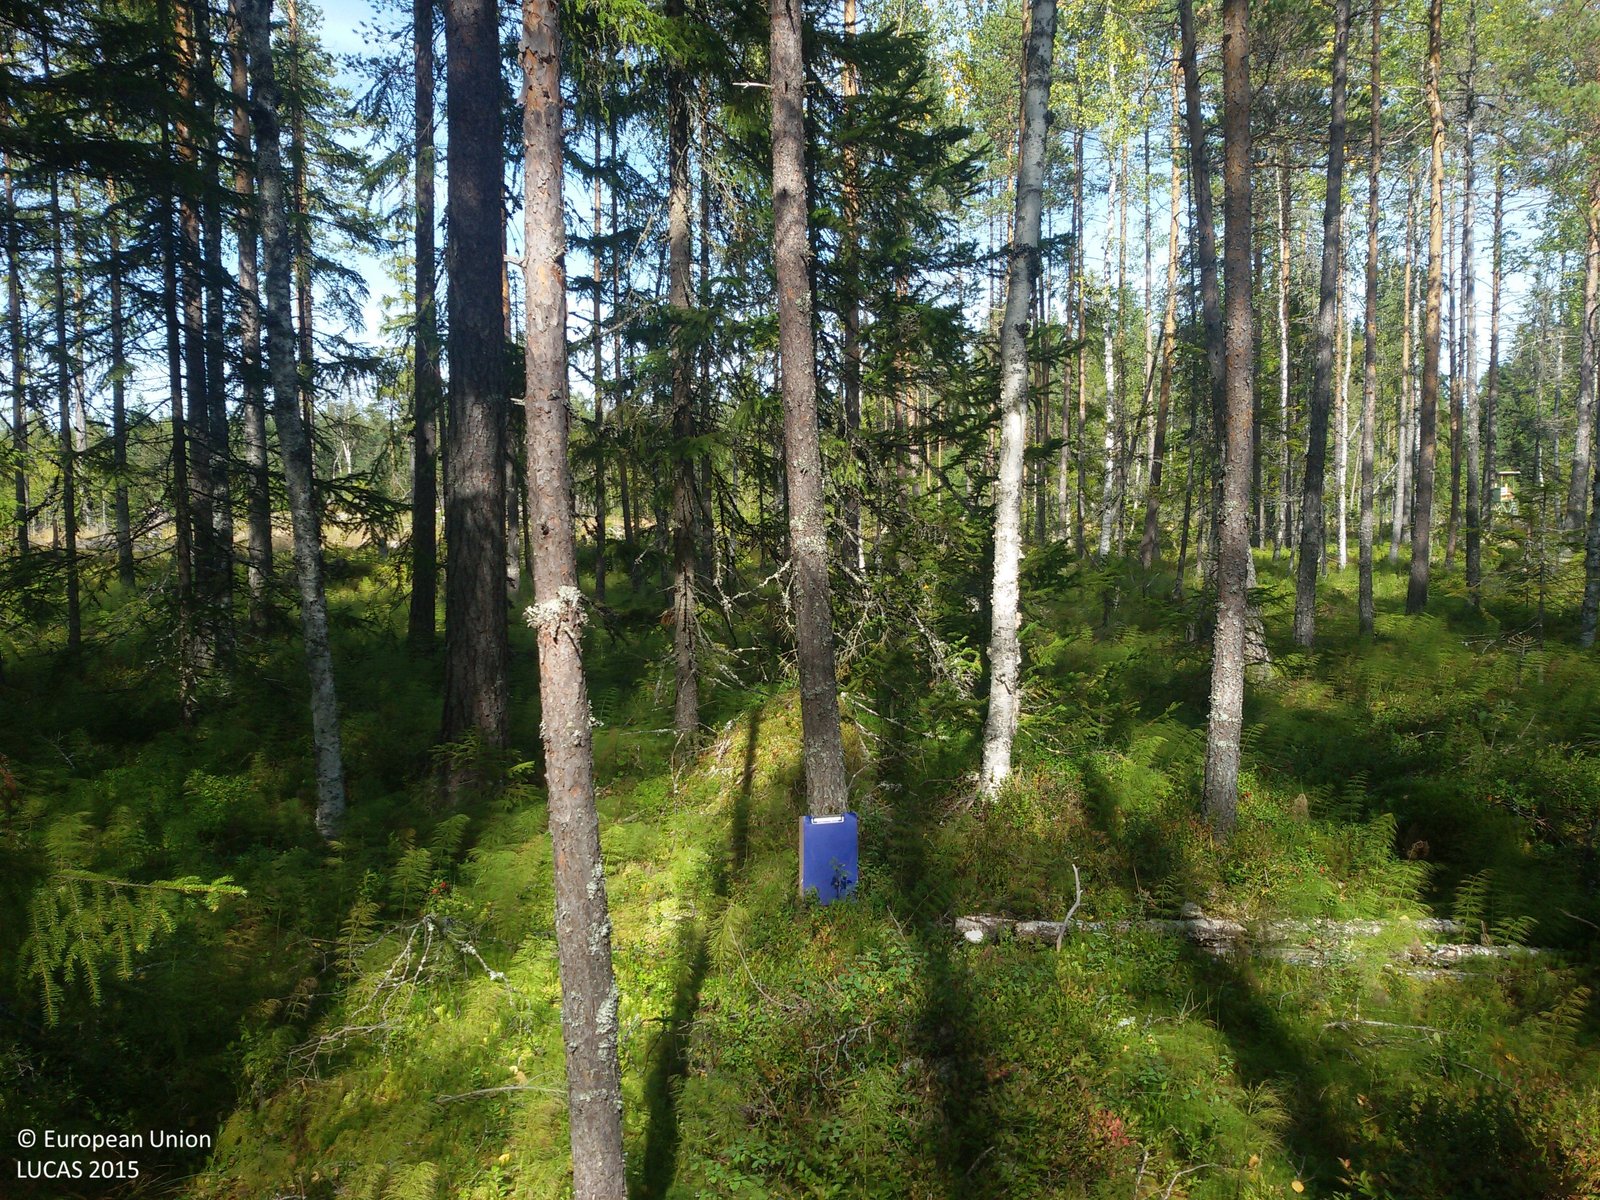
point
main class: Woodland
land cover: Pine dominated mixed woodland
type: boreal forest
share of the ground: 50 - 75 %
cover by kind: coniferous forest trees 40 %, broadleaved forest trees 30 %, lichens and mosses 20 %, herbaceous plants 10 %
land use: Forestry
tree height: > 5 m
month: September
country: SE
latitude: 61.0020
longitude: 15.2931
